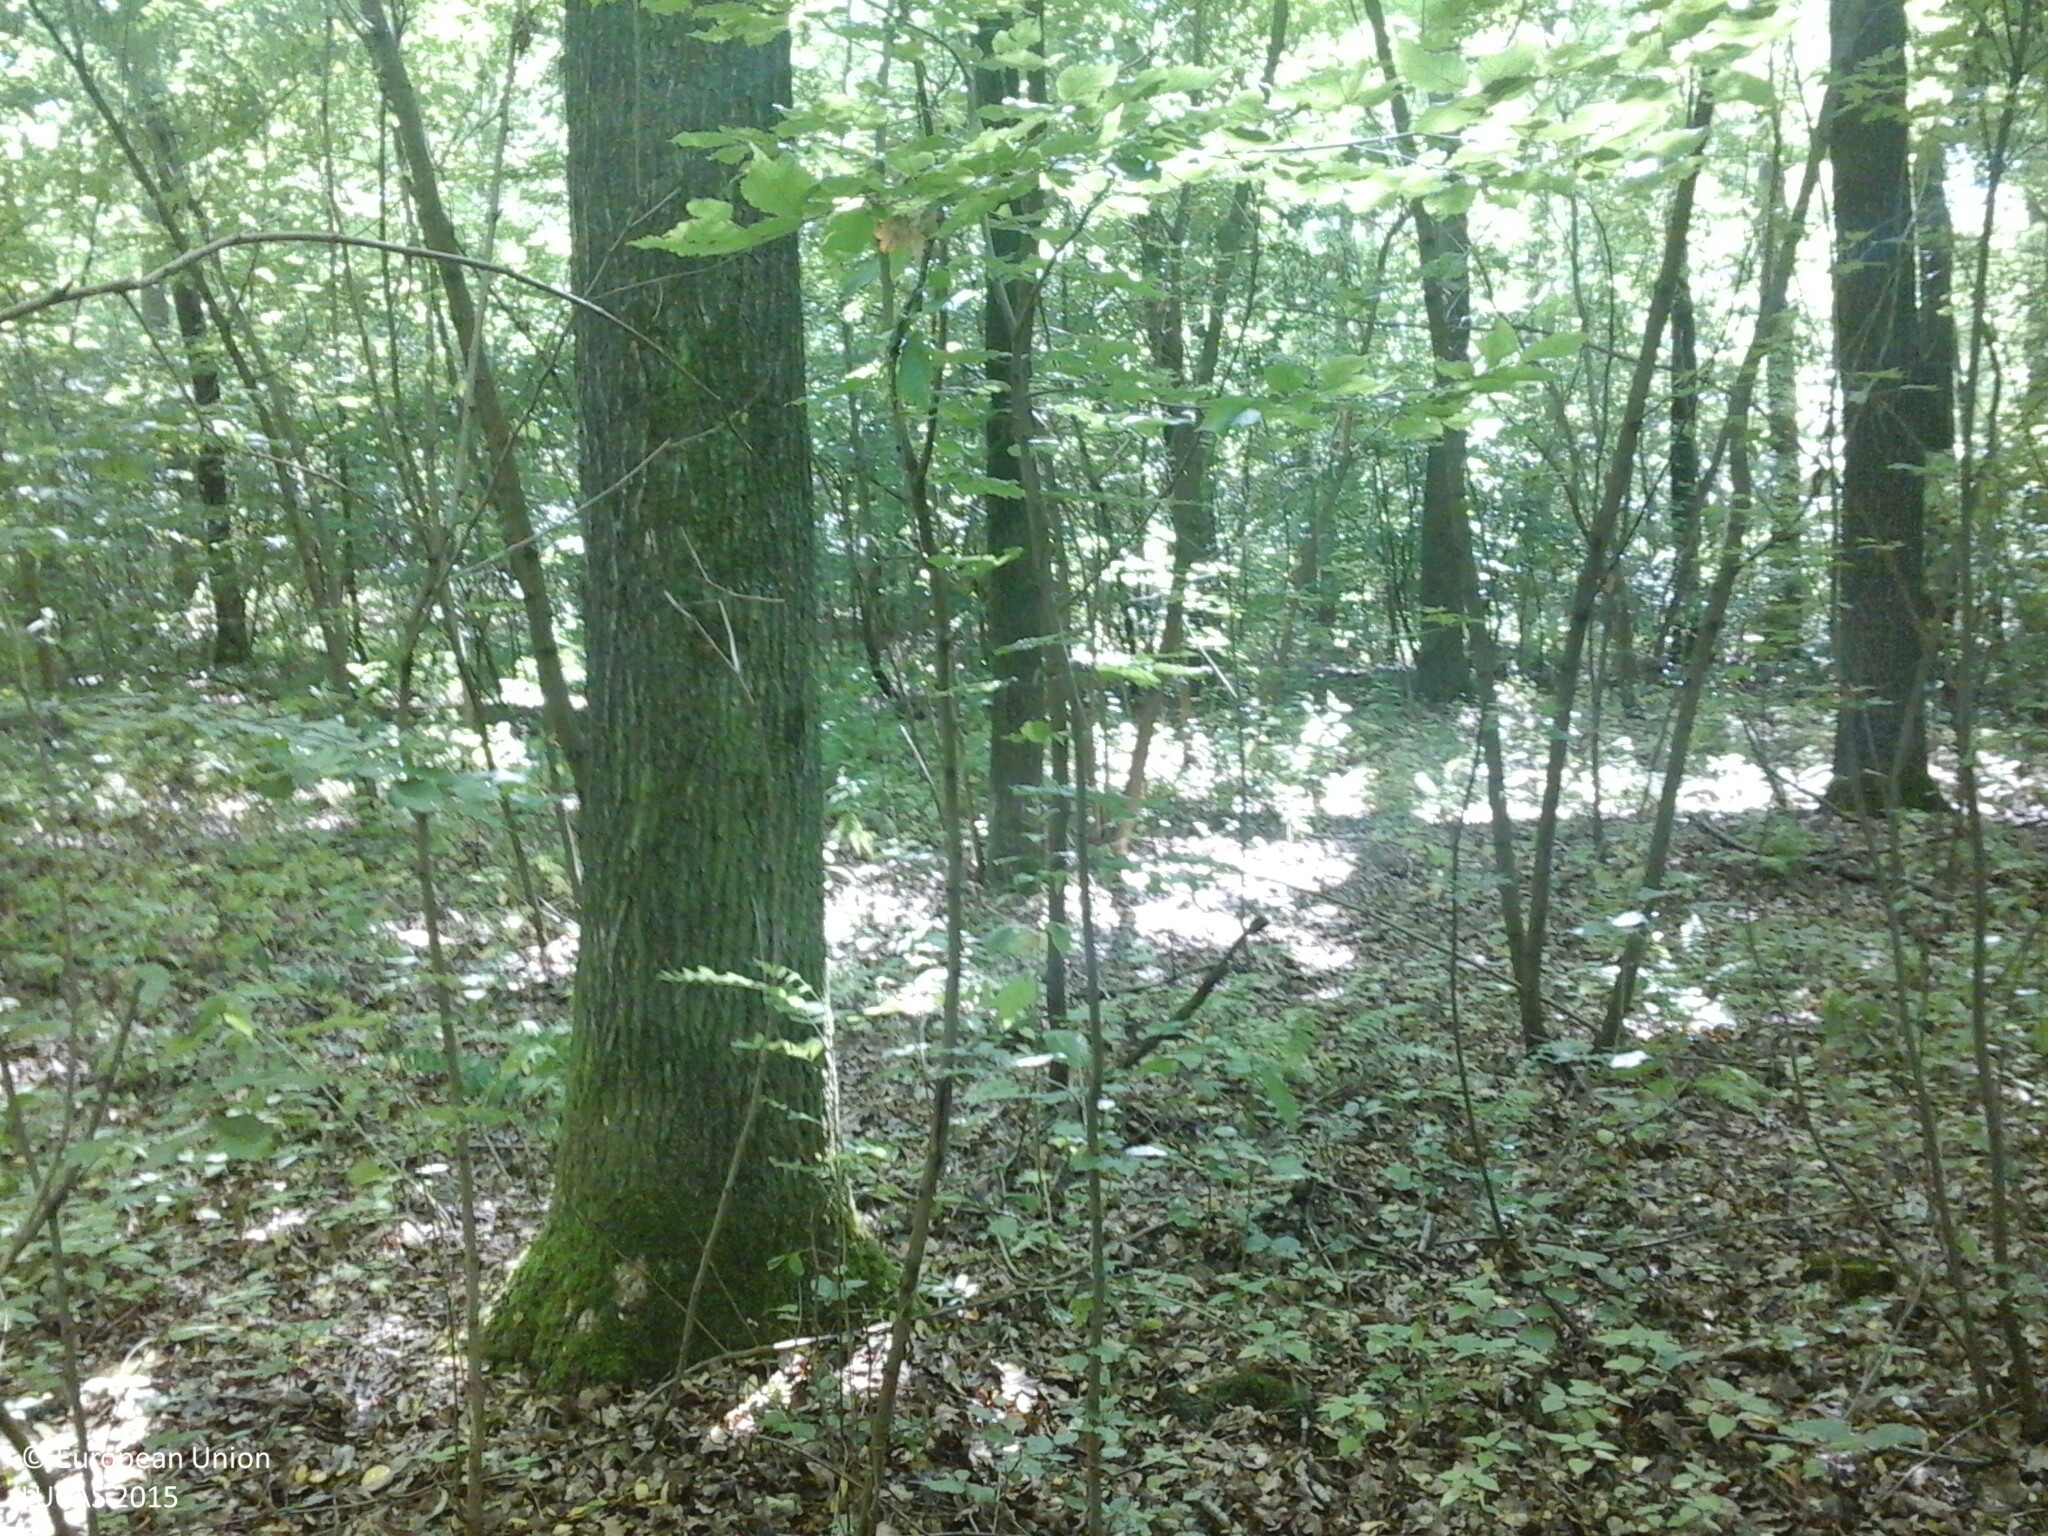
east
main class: Woodland
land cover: Broadleaved woodland
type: mesophytic deciduous forest
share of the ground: > 75 %
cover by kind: broadleaved forest trees 90 %, herbaceous plants 10 %
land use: Forestry
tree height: > 5 m
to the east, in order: Broadleaved woodland; Tracks; Broadleaved woodland; Maize; Electric lines; Maize
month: July
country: HU
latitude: 48.0616
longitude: 22.2808
